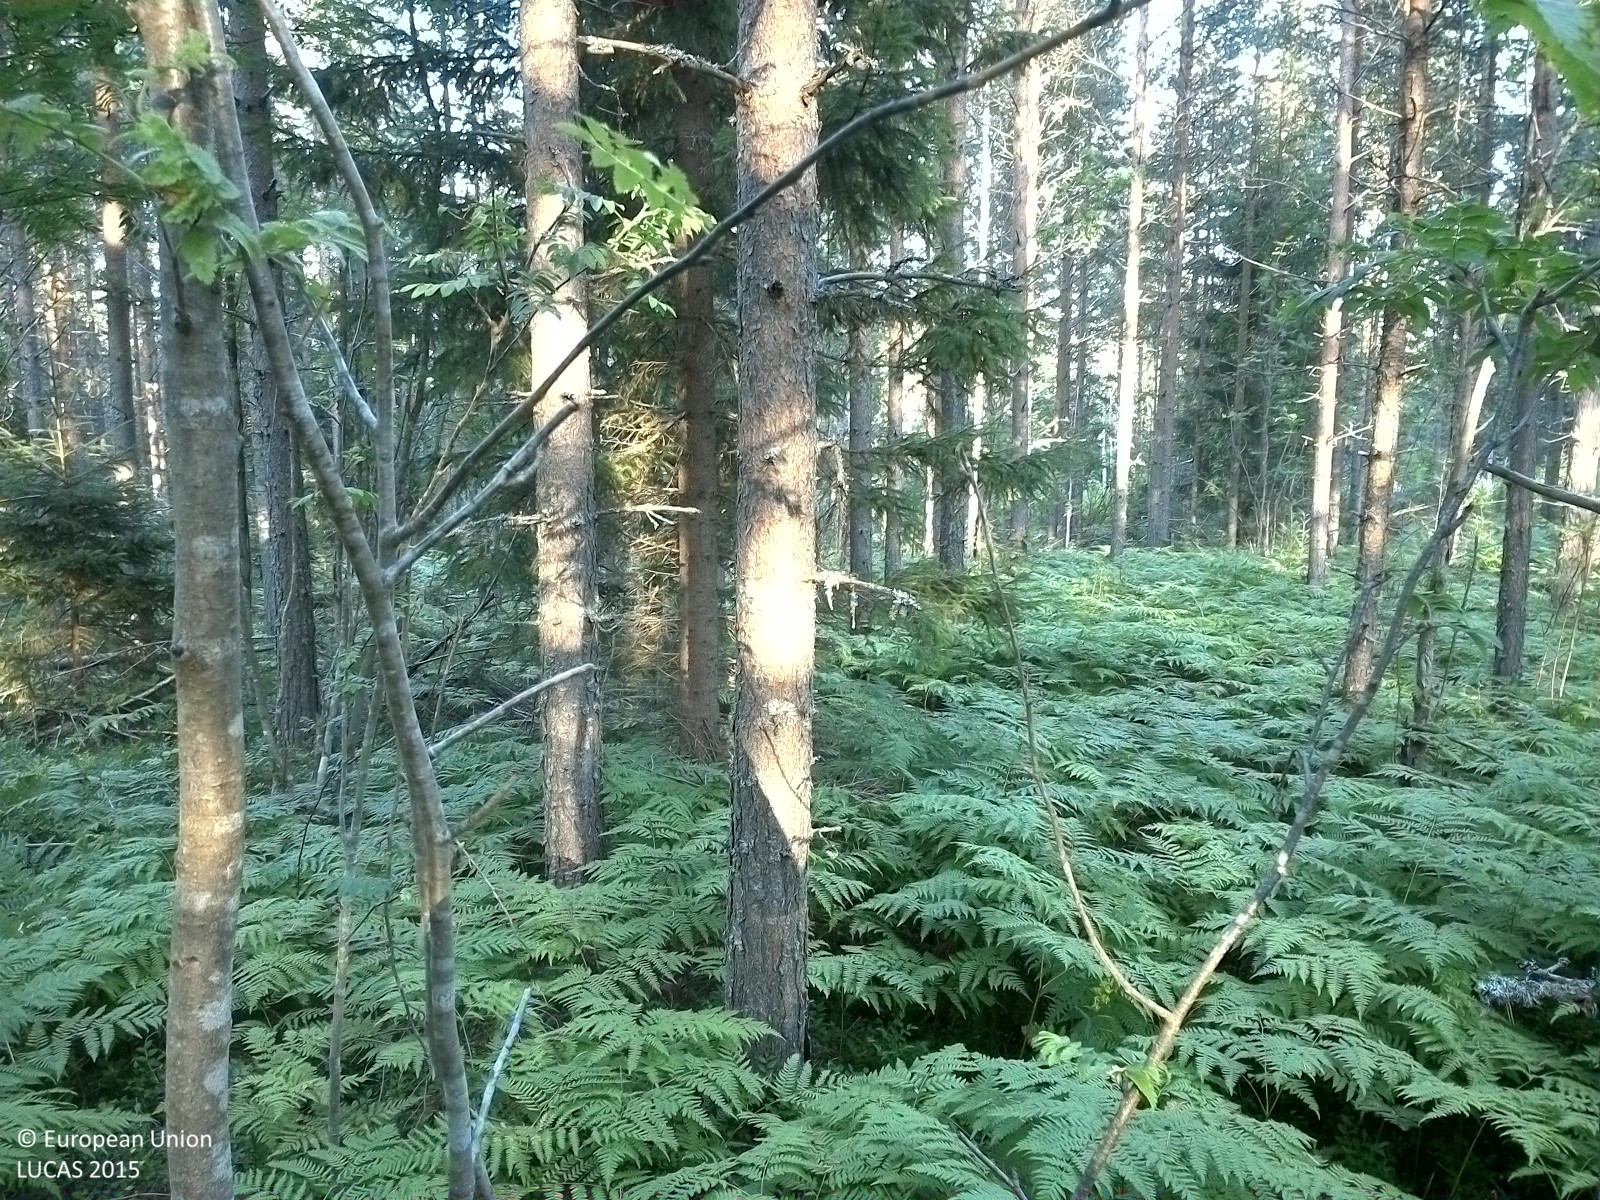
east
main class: Woodland
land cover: Pine dominated coniferous woodland
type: boreal forest
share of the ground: 50 - 75 %
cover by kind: coniferous forest trees 55 %, herbaceous plants 30 %, shrubs 15 %
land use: Forestry
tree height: > 5 m
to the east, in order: Pine dominated coniferous woodland; Grassland without tree/shrub cover; Broadleaved woodland; Ditches and canals; Paved roads, cycling and walking lanes; Ditches and canals; Other mixed woodland; Paved roads, cycling and walking lanes; Other mixed woodland; Artificial constructions in urban areas
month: August
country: SE
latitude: 62.5859
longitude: 17.9042
